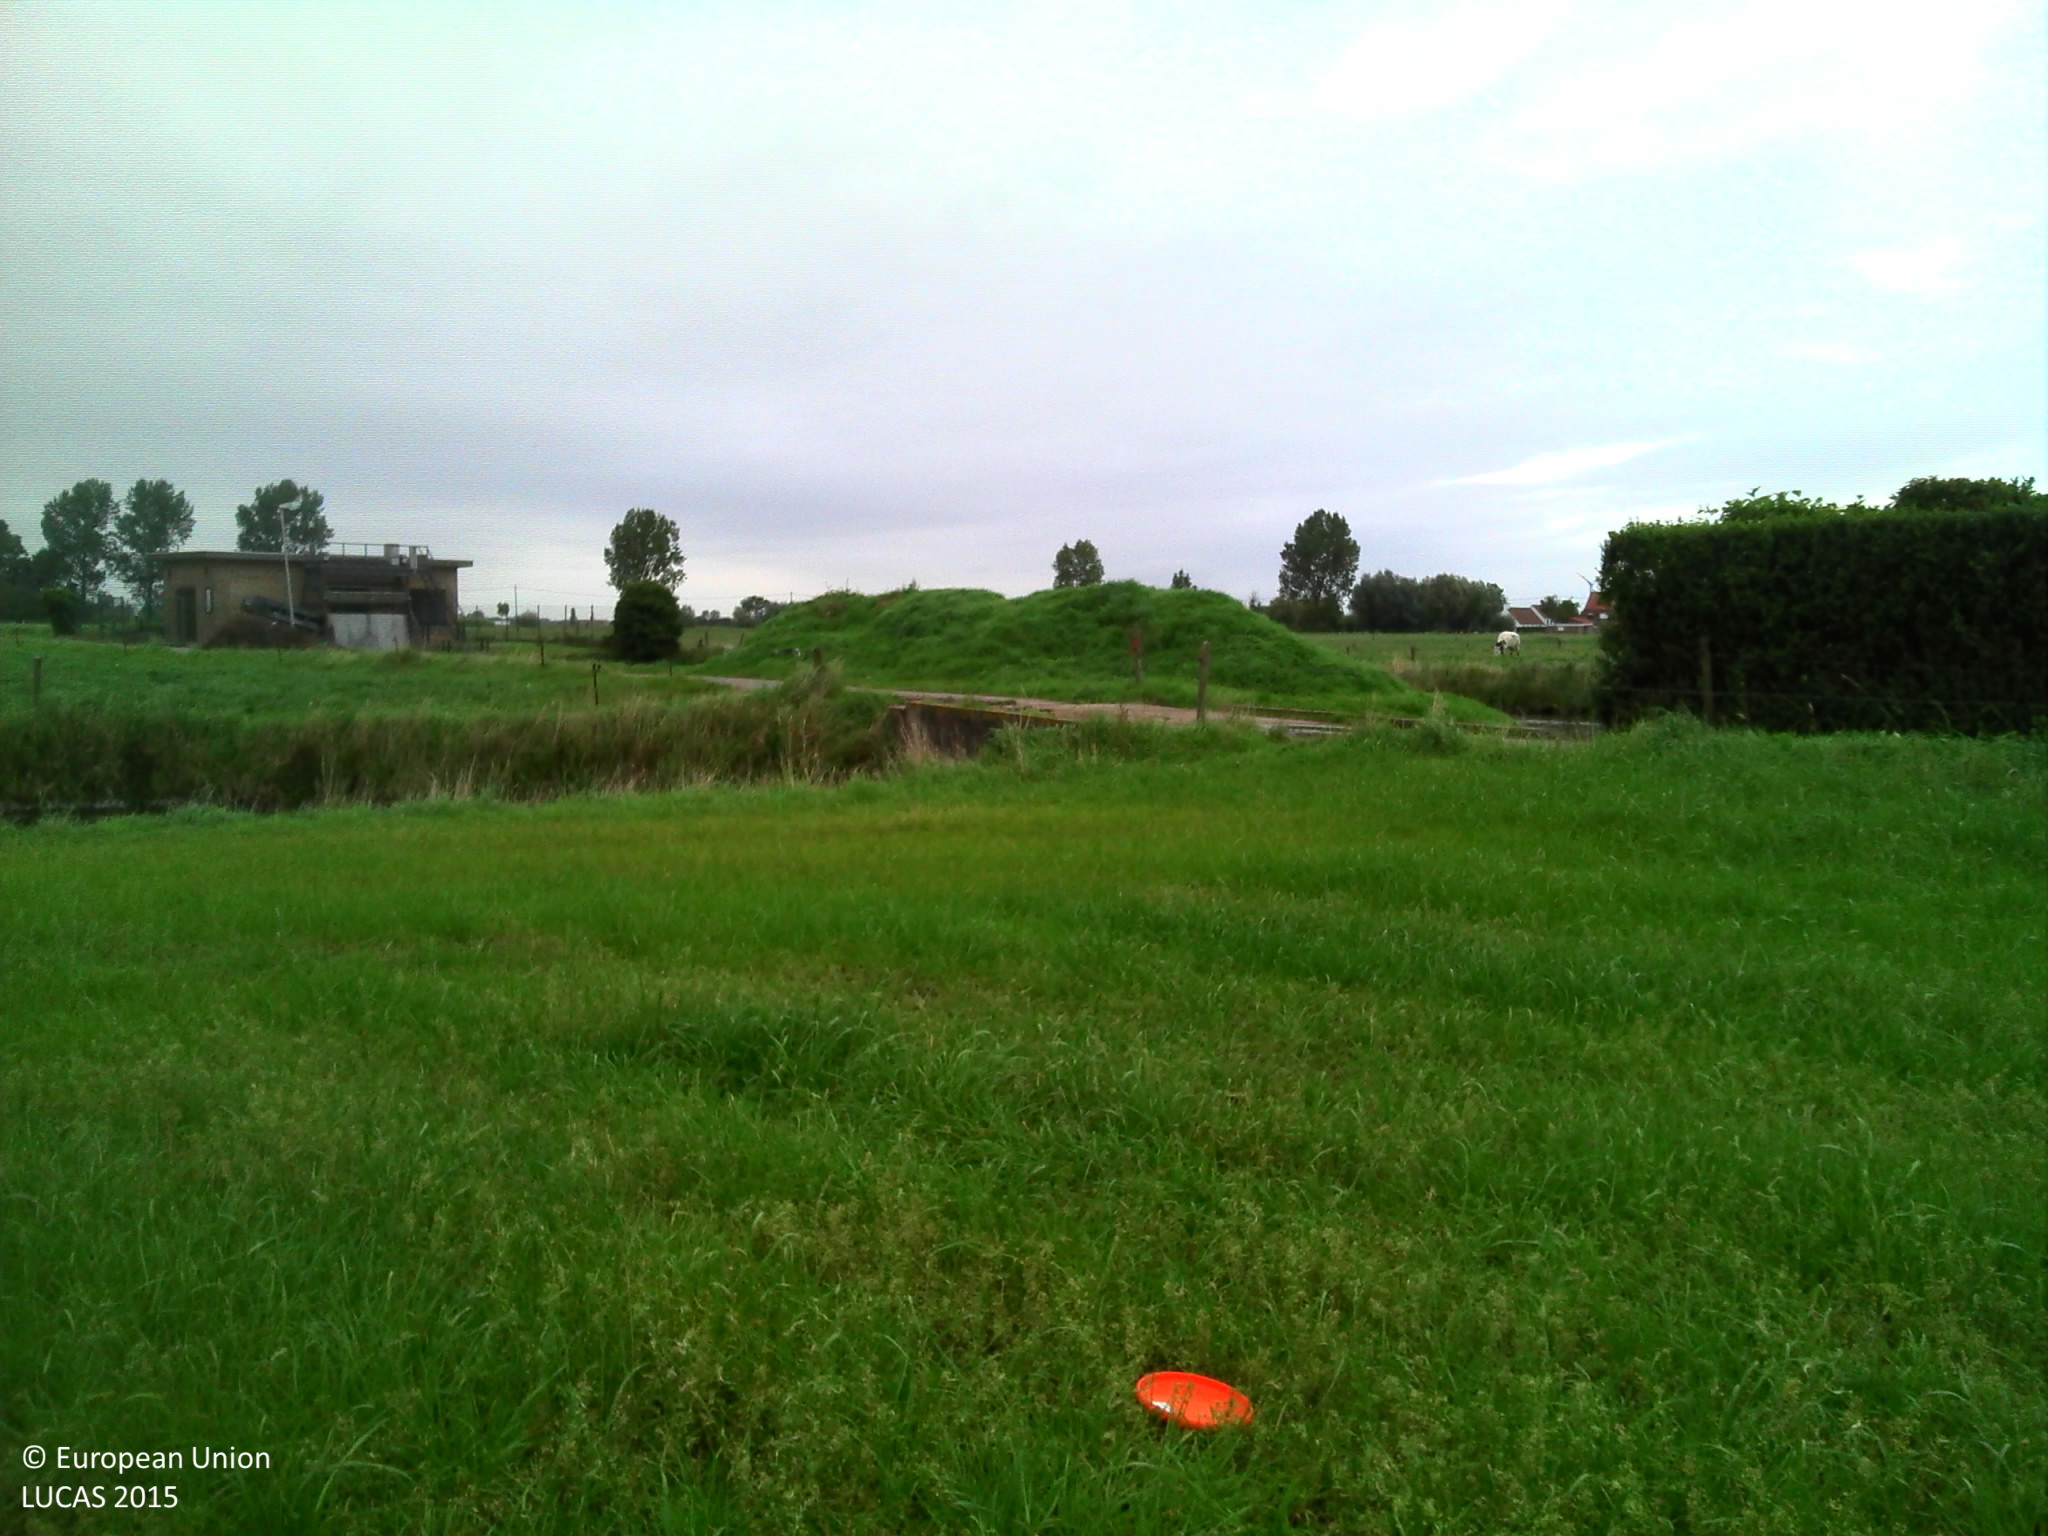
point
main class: Cropland
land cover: Temporary grasslands
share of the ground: > 75 %
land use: Agriculture (excluding fallow land and kitchen gardens)
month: September
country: BE
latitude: 51.1370
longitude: 2.9149
